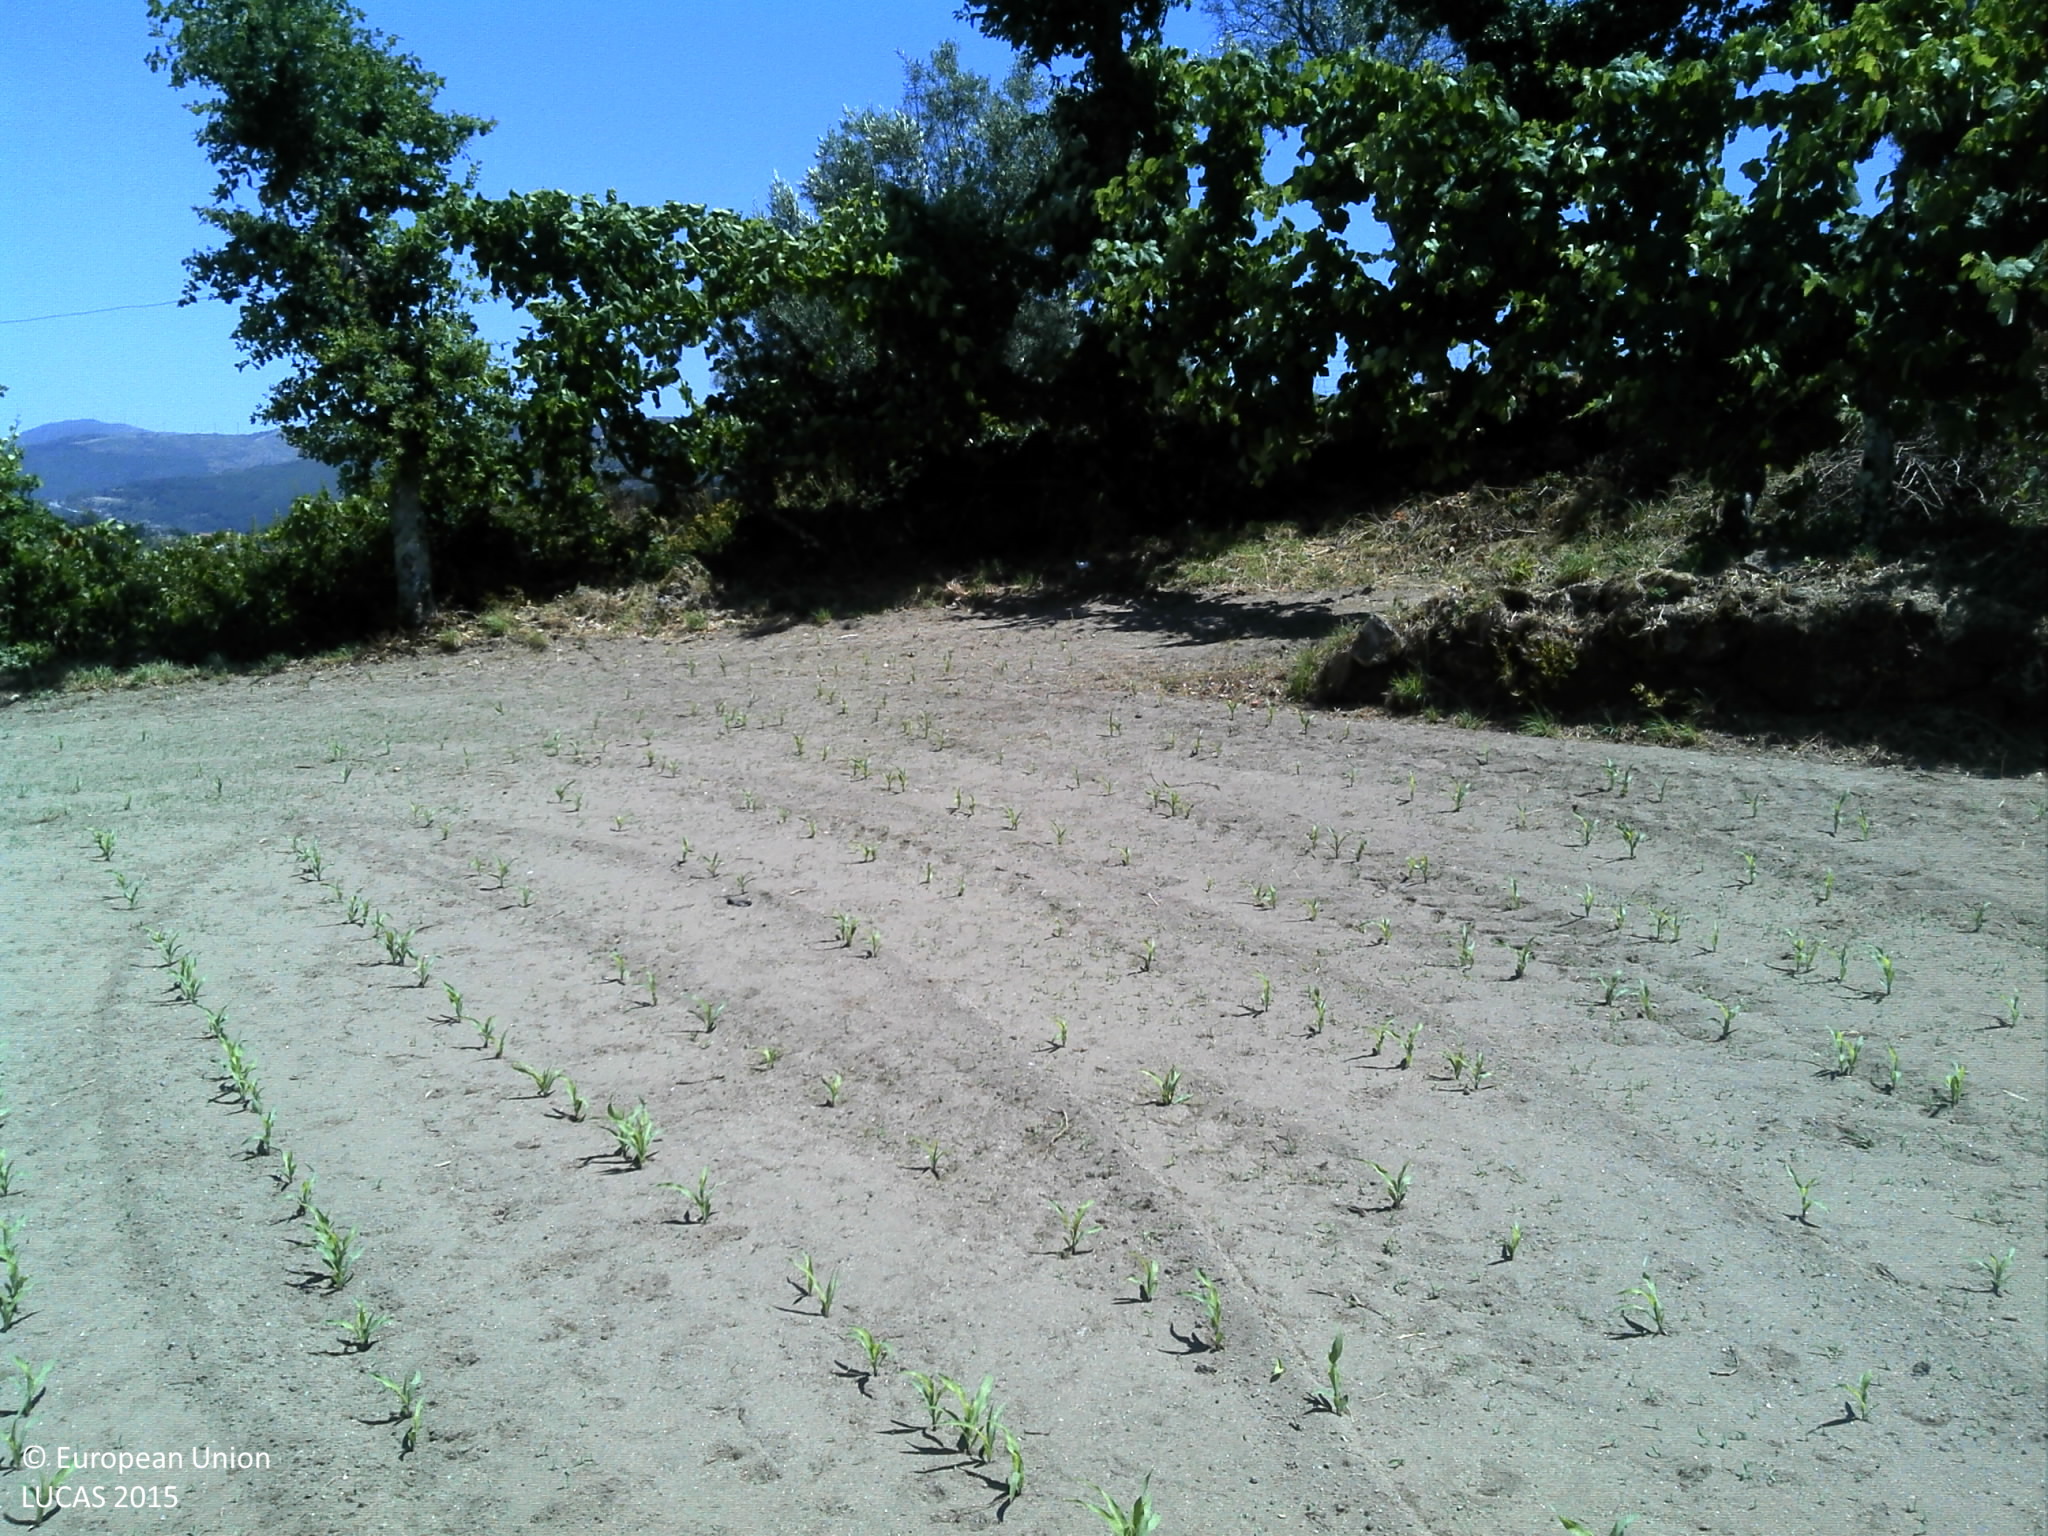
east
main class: Cropland
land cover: Maize
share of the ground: < 10 %
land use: Agriculture (excluding fallow land and kitchen gardens)
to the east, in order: Maize; Abandoned hedges; Tracks; Dry stone walls; Fences; Grassland without tree/shrub cover; Fences; Grassland without tree/shrub cover; Broadleaved woodland; Shrubland without tree cover; Broadleaved woodland
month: July
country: PT
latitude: 41.5172
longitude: -7.8349
